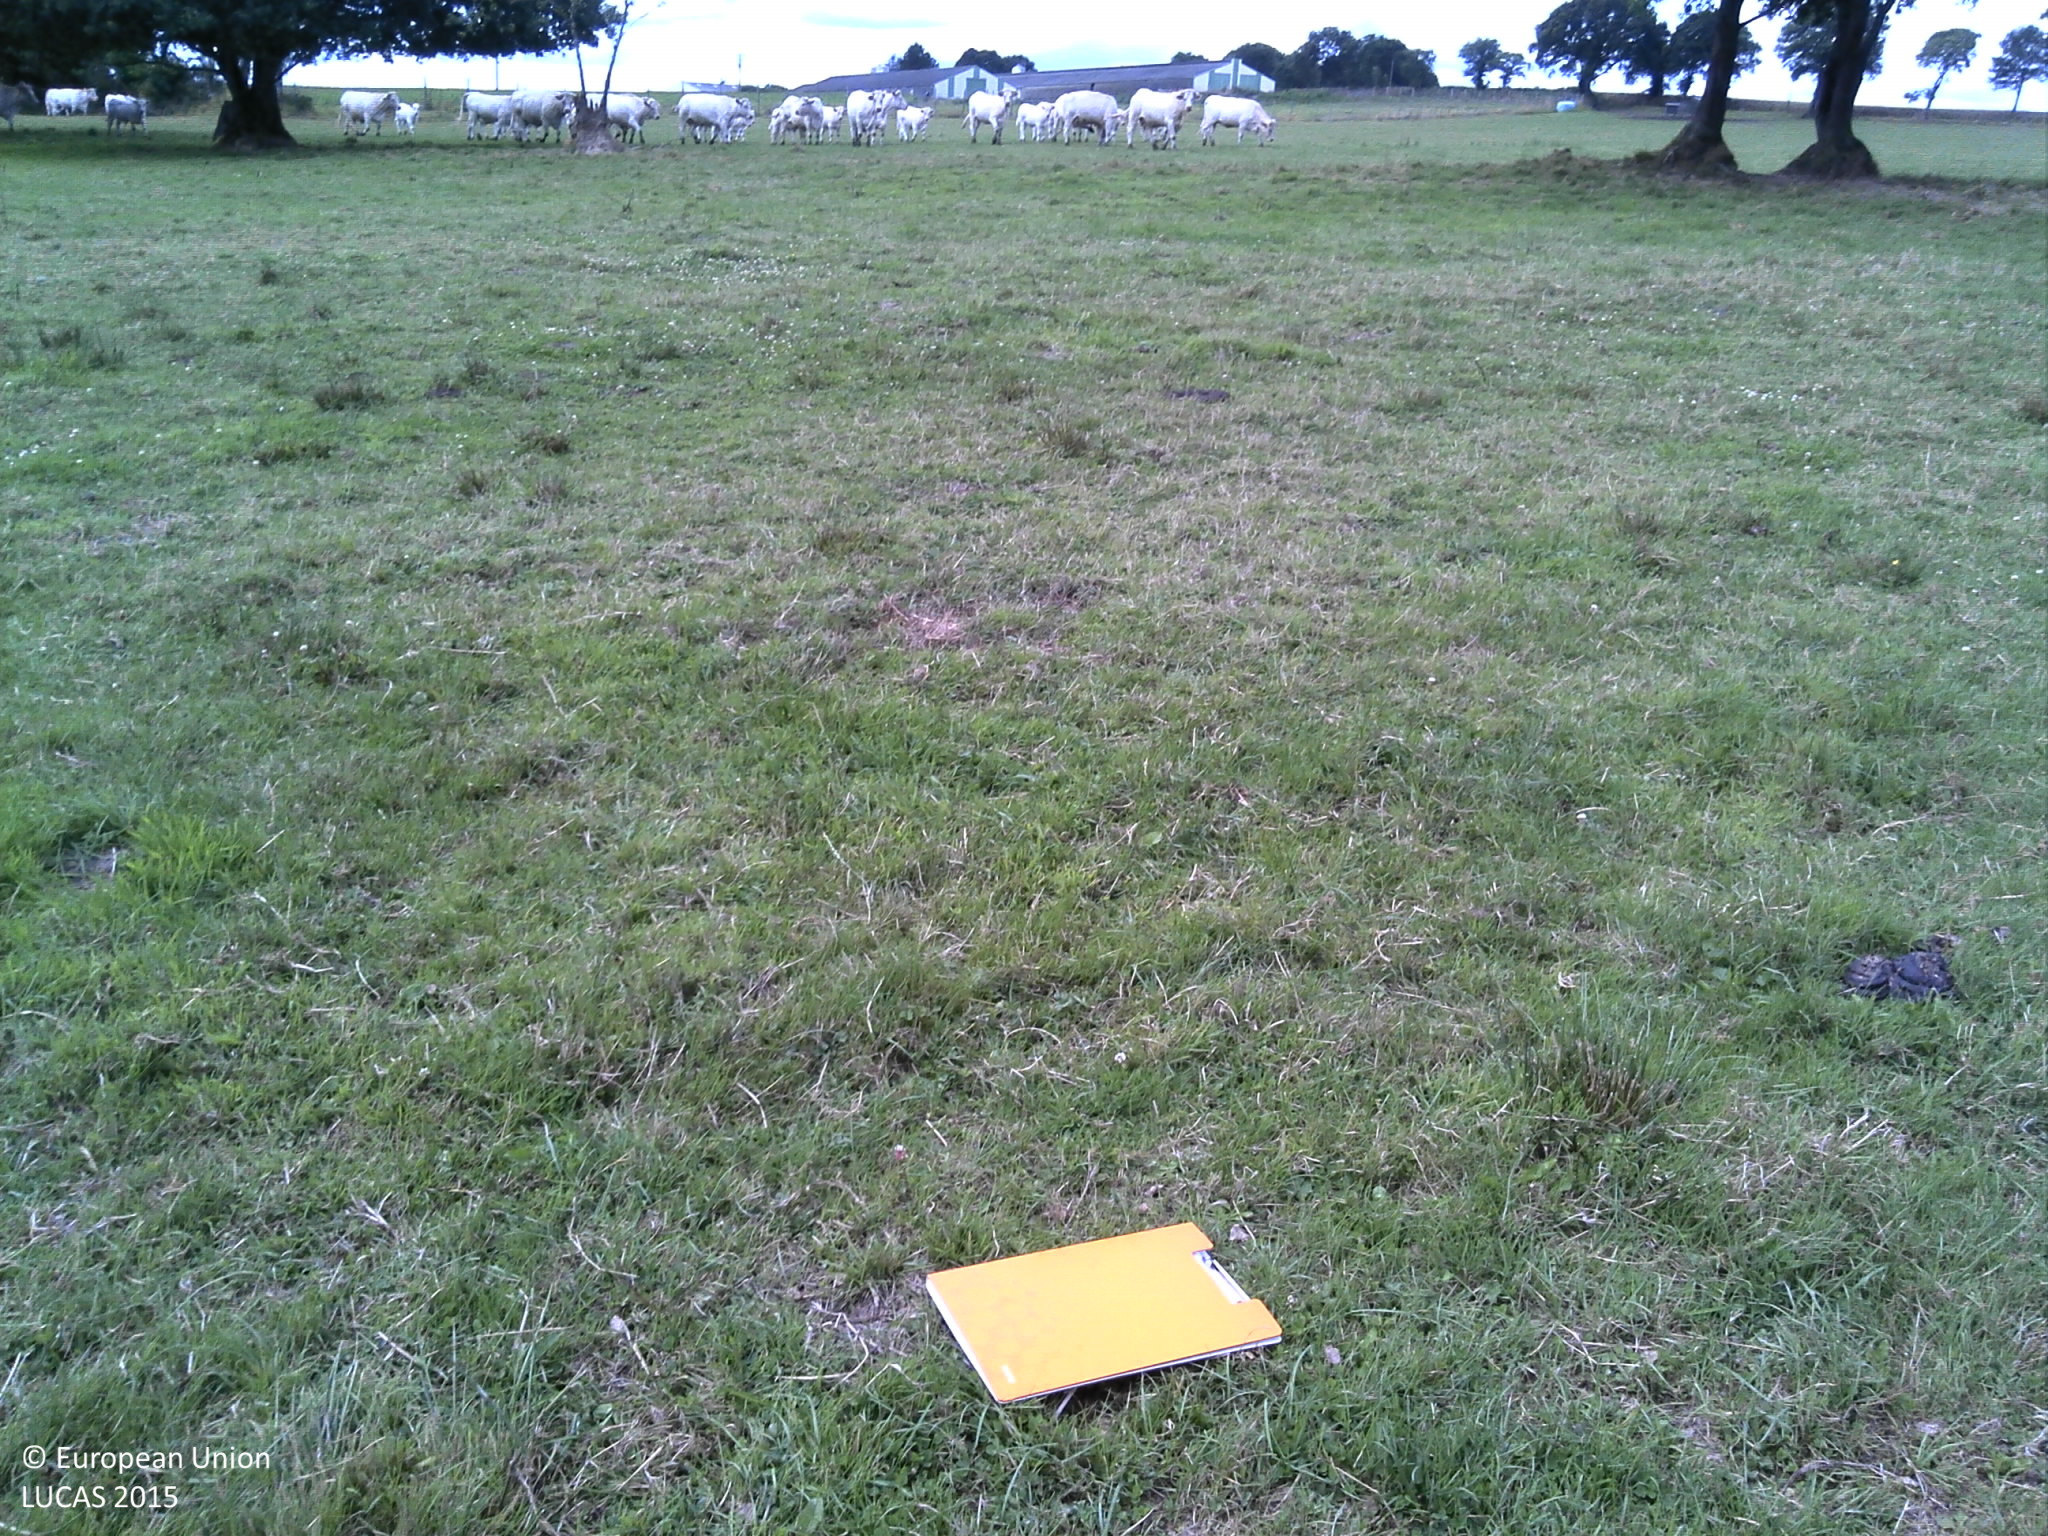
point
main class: Grassland
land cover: Grassland without tree/shrub cover
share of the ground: > 75 %
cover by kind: herbaceous plants 100 %
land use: Agriculture (excluding fallow land and kitchen gardens)
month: July
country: FR
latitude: 48.2784
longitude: -3.6777
